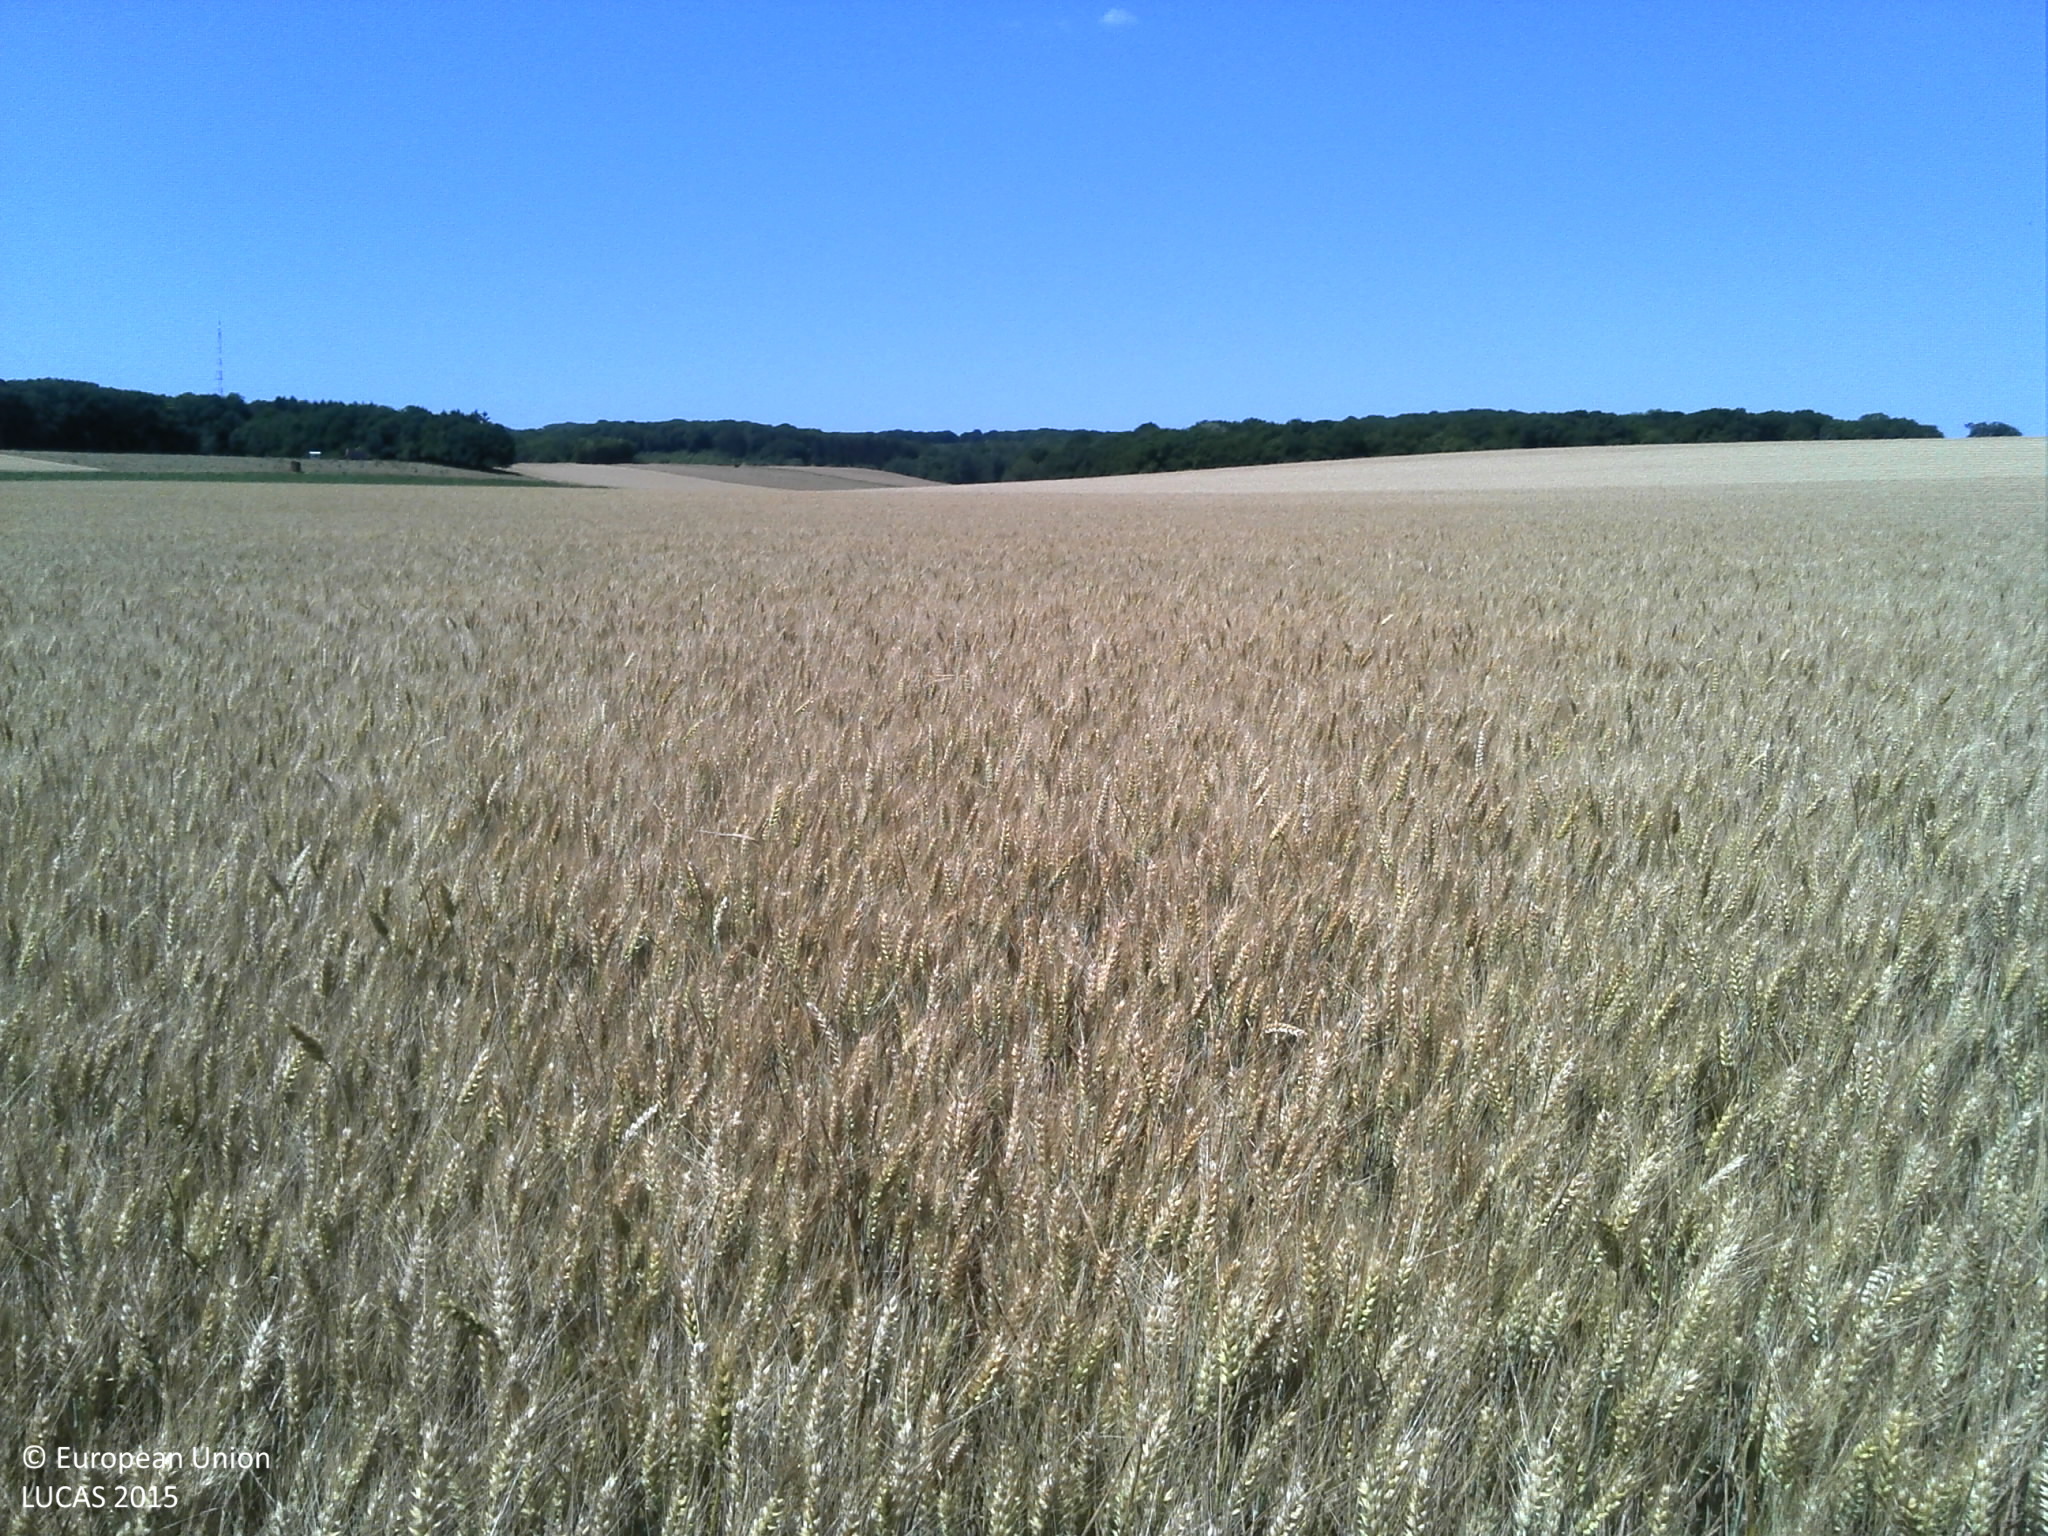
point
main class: Cropland
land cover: Common wheat
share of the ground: > 75 %
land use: Agriculture (excluding fallow land and kitchen gardens)
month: July
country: FR
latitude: 49.4900
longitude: 6.1755
